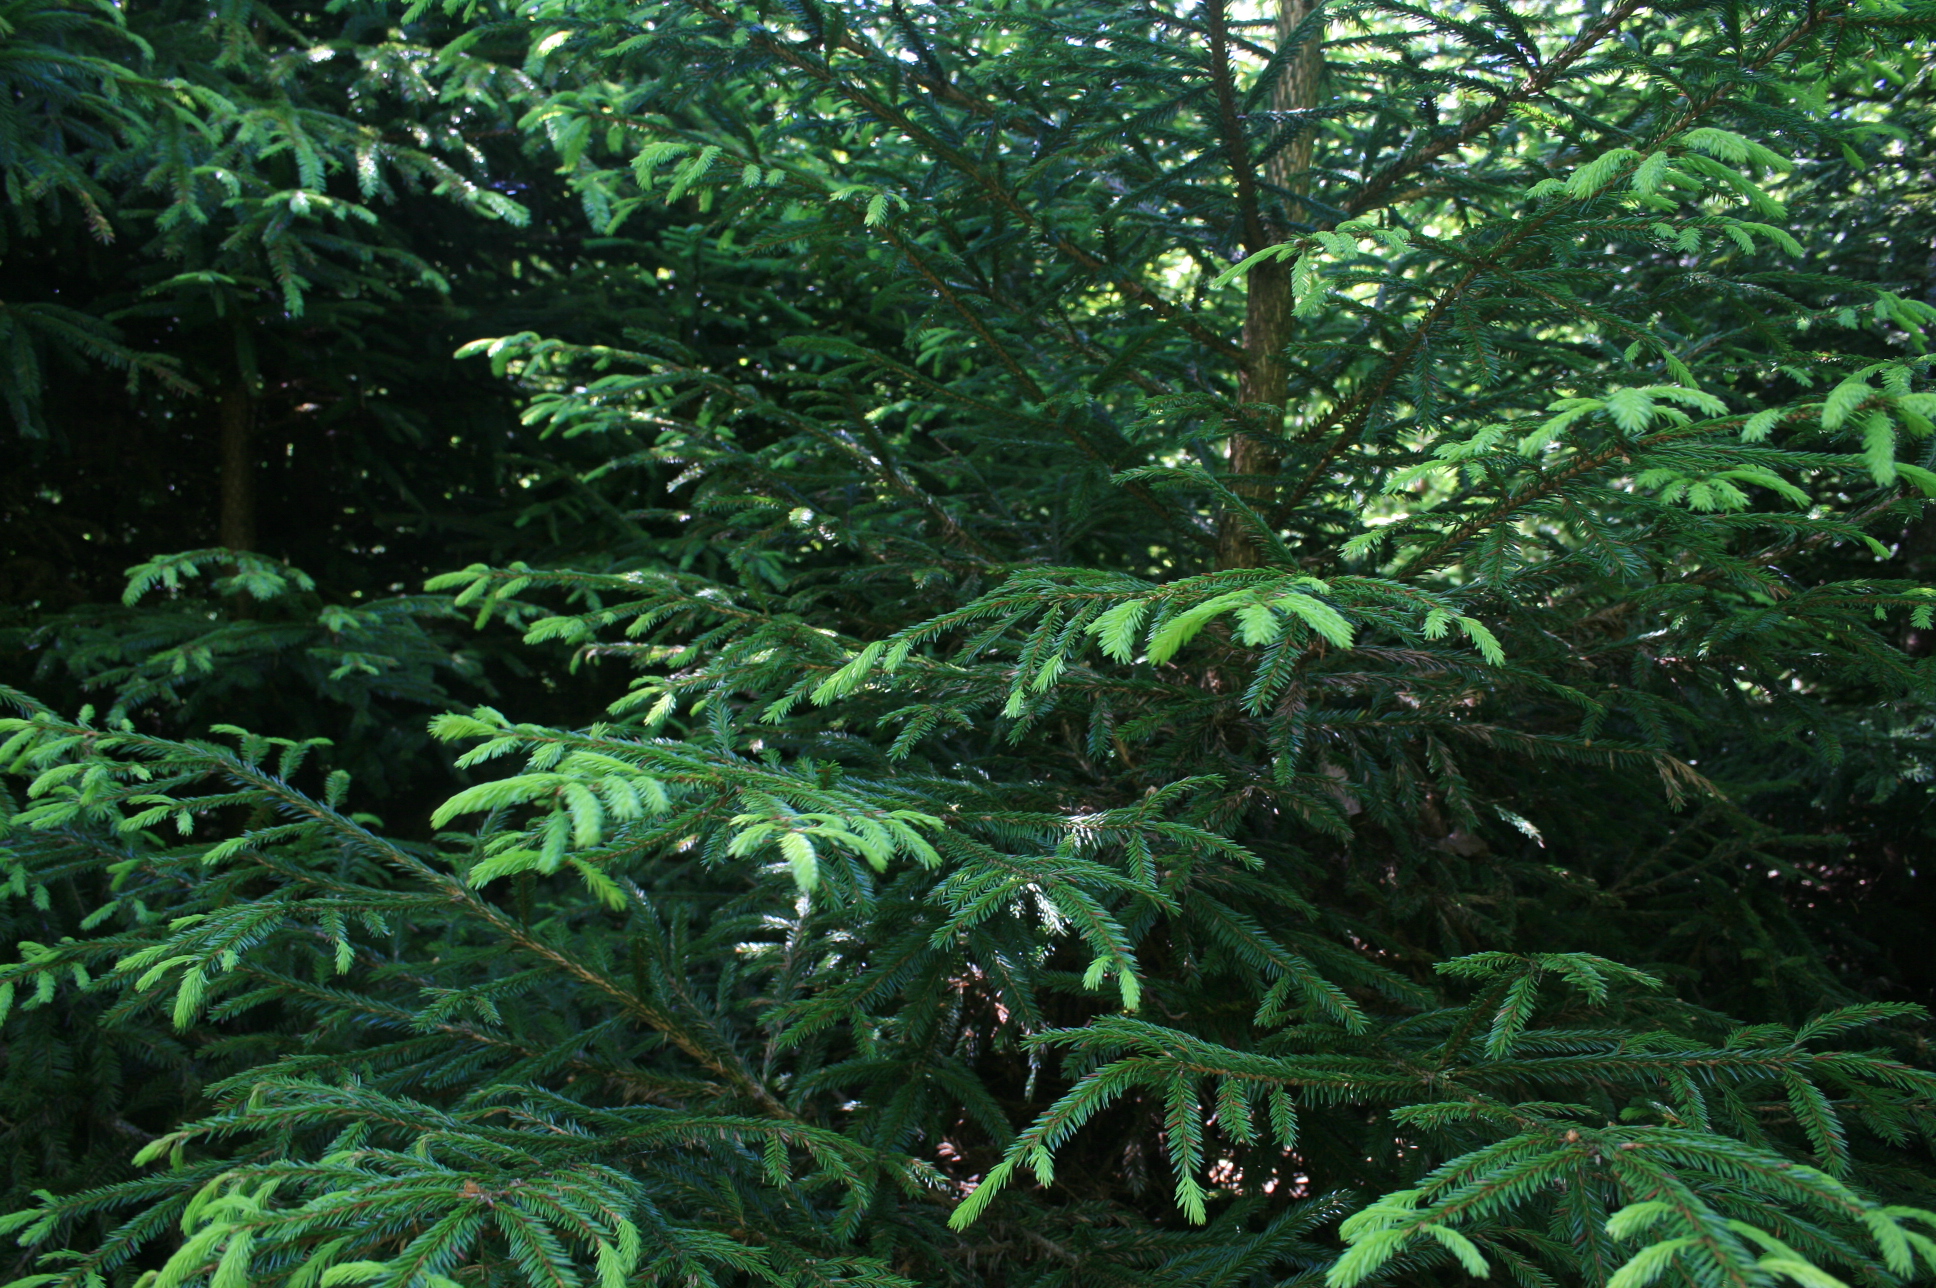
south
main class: Woodland
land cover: Spruce dominated coniferous woodland
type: hemiboreal forest and nemoral coniferous forest and mixed broadleaved-coniferous forest
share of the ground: > 75 %
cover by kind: coniferous forest trees 80 %, broadleaved forest trees 20 %
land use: Forestry
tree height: < 5 m
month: June
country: LT
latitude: 55.4587
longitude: 22.1855
